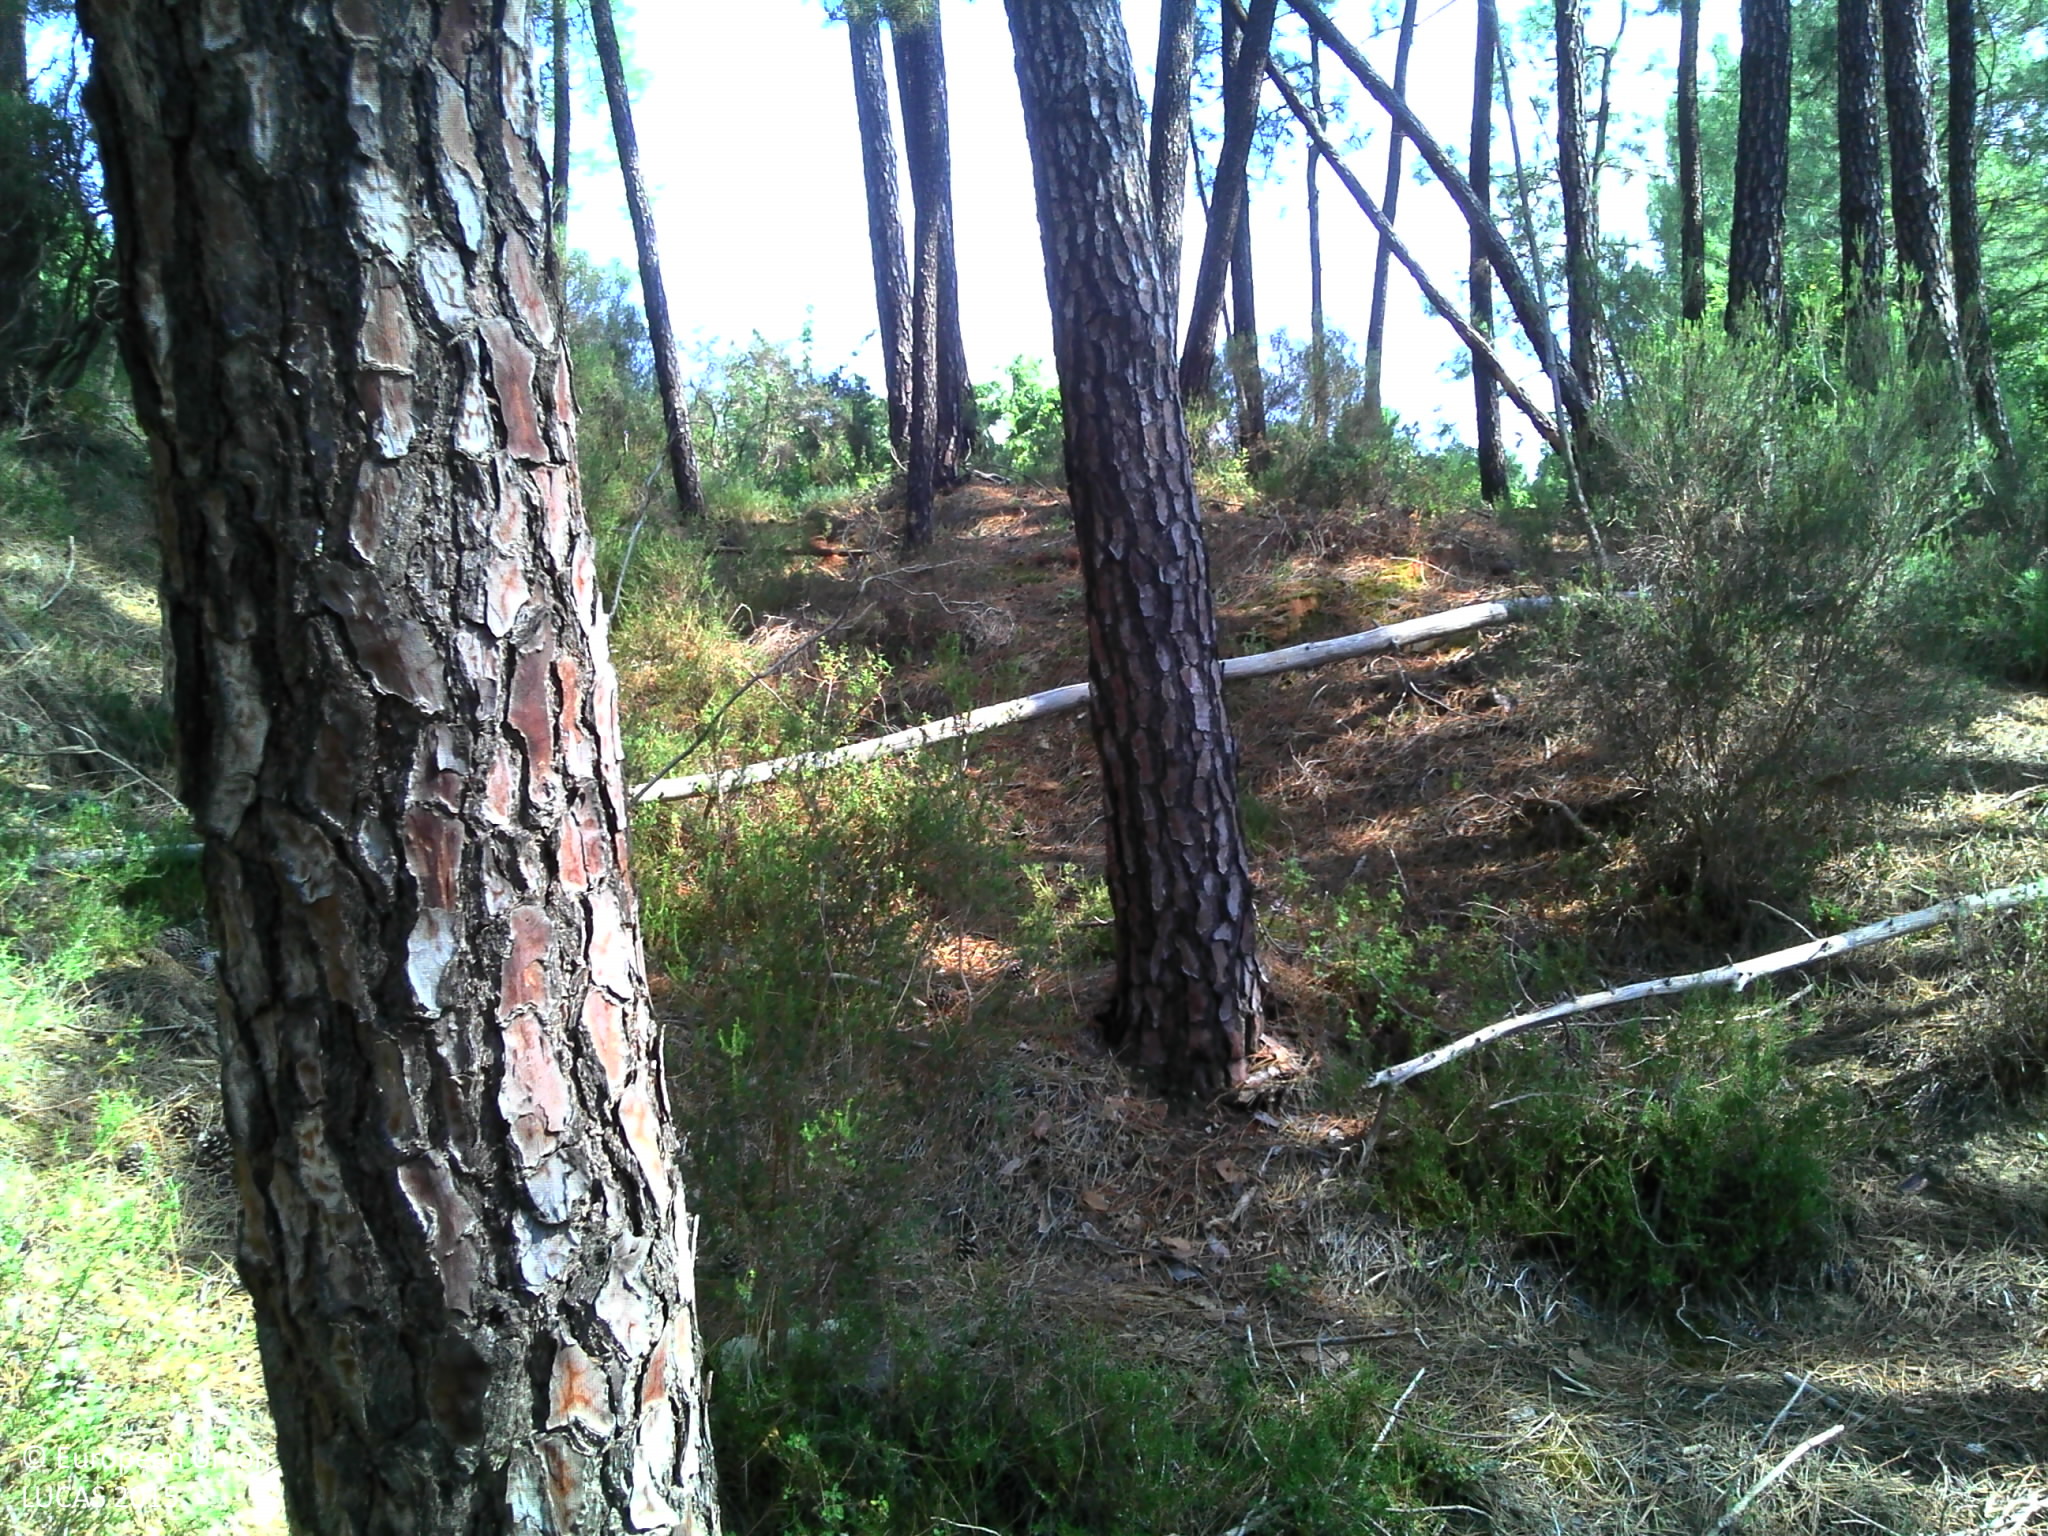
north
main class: Woodland
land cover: Pine dominated coniferous woodland
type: coniferous forest of the mediterranean region
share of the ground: > 75 %
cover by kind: coniferous forest trees 75 %, shrubs 15 %, herbaceous plants 10 %
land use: Forestry
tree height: > 5 m
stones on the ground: 10 - 25 %
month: July
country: FR
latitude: 44.0781
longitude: 5.2256
